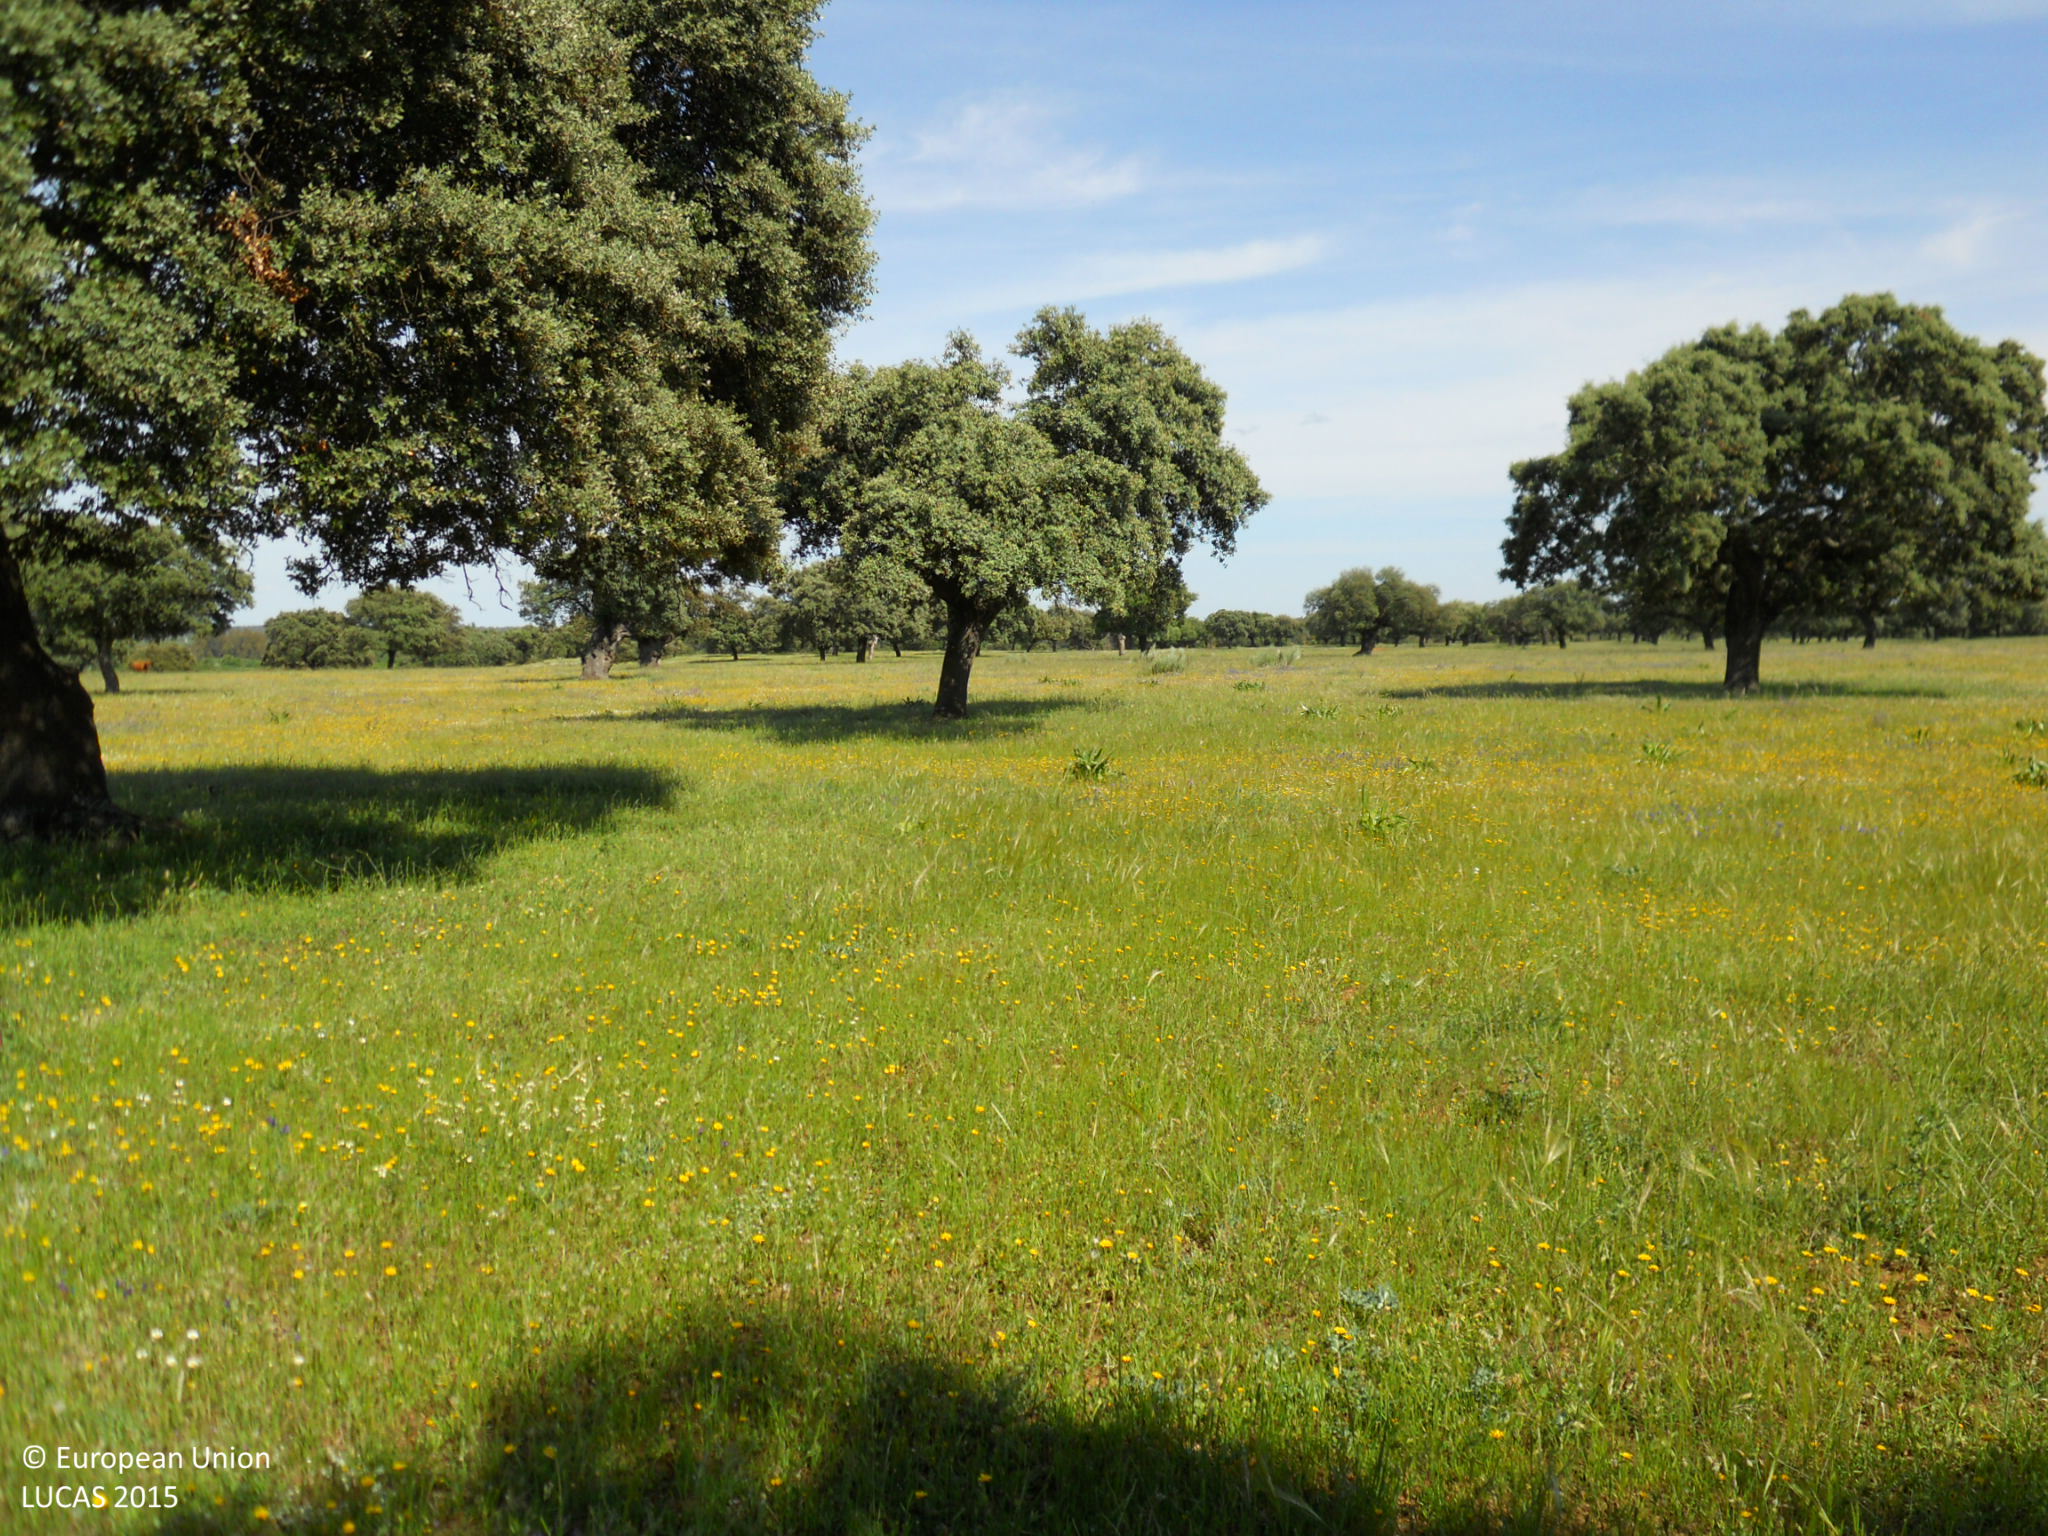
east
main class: Grassland
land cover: Grassland without tree/shrub cover
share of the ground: > 75 %
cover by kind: herbaceous plants 100 %
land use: Agriculture (excluding fallow land and kitchen gardens)
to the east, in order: Grassland without tree/shrub cover; Other structural elements; Fences; Broadleaved woodland
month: April
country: ES
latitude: 39.0031
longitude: -6.9419
